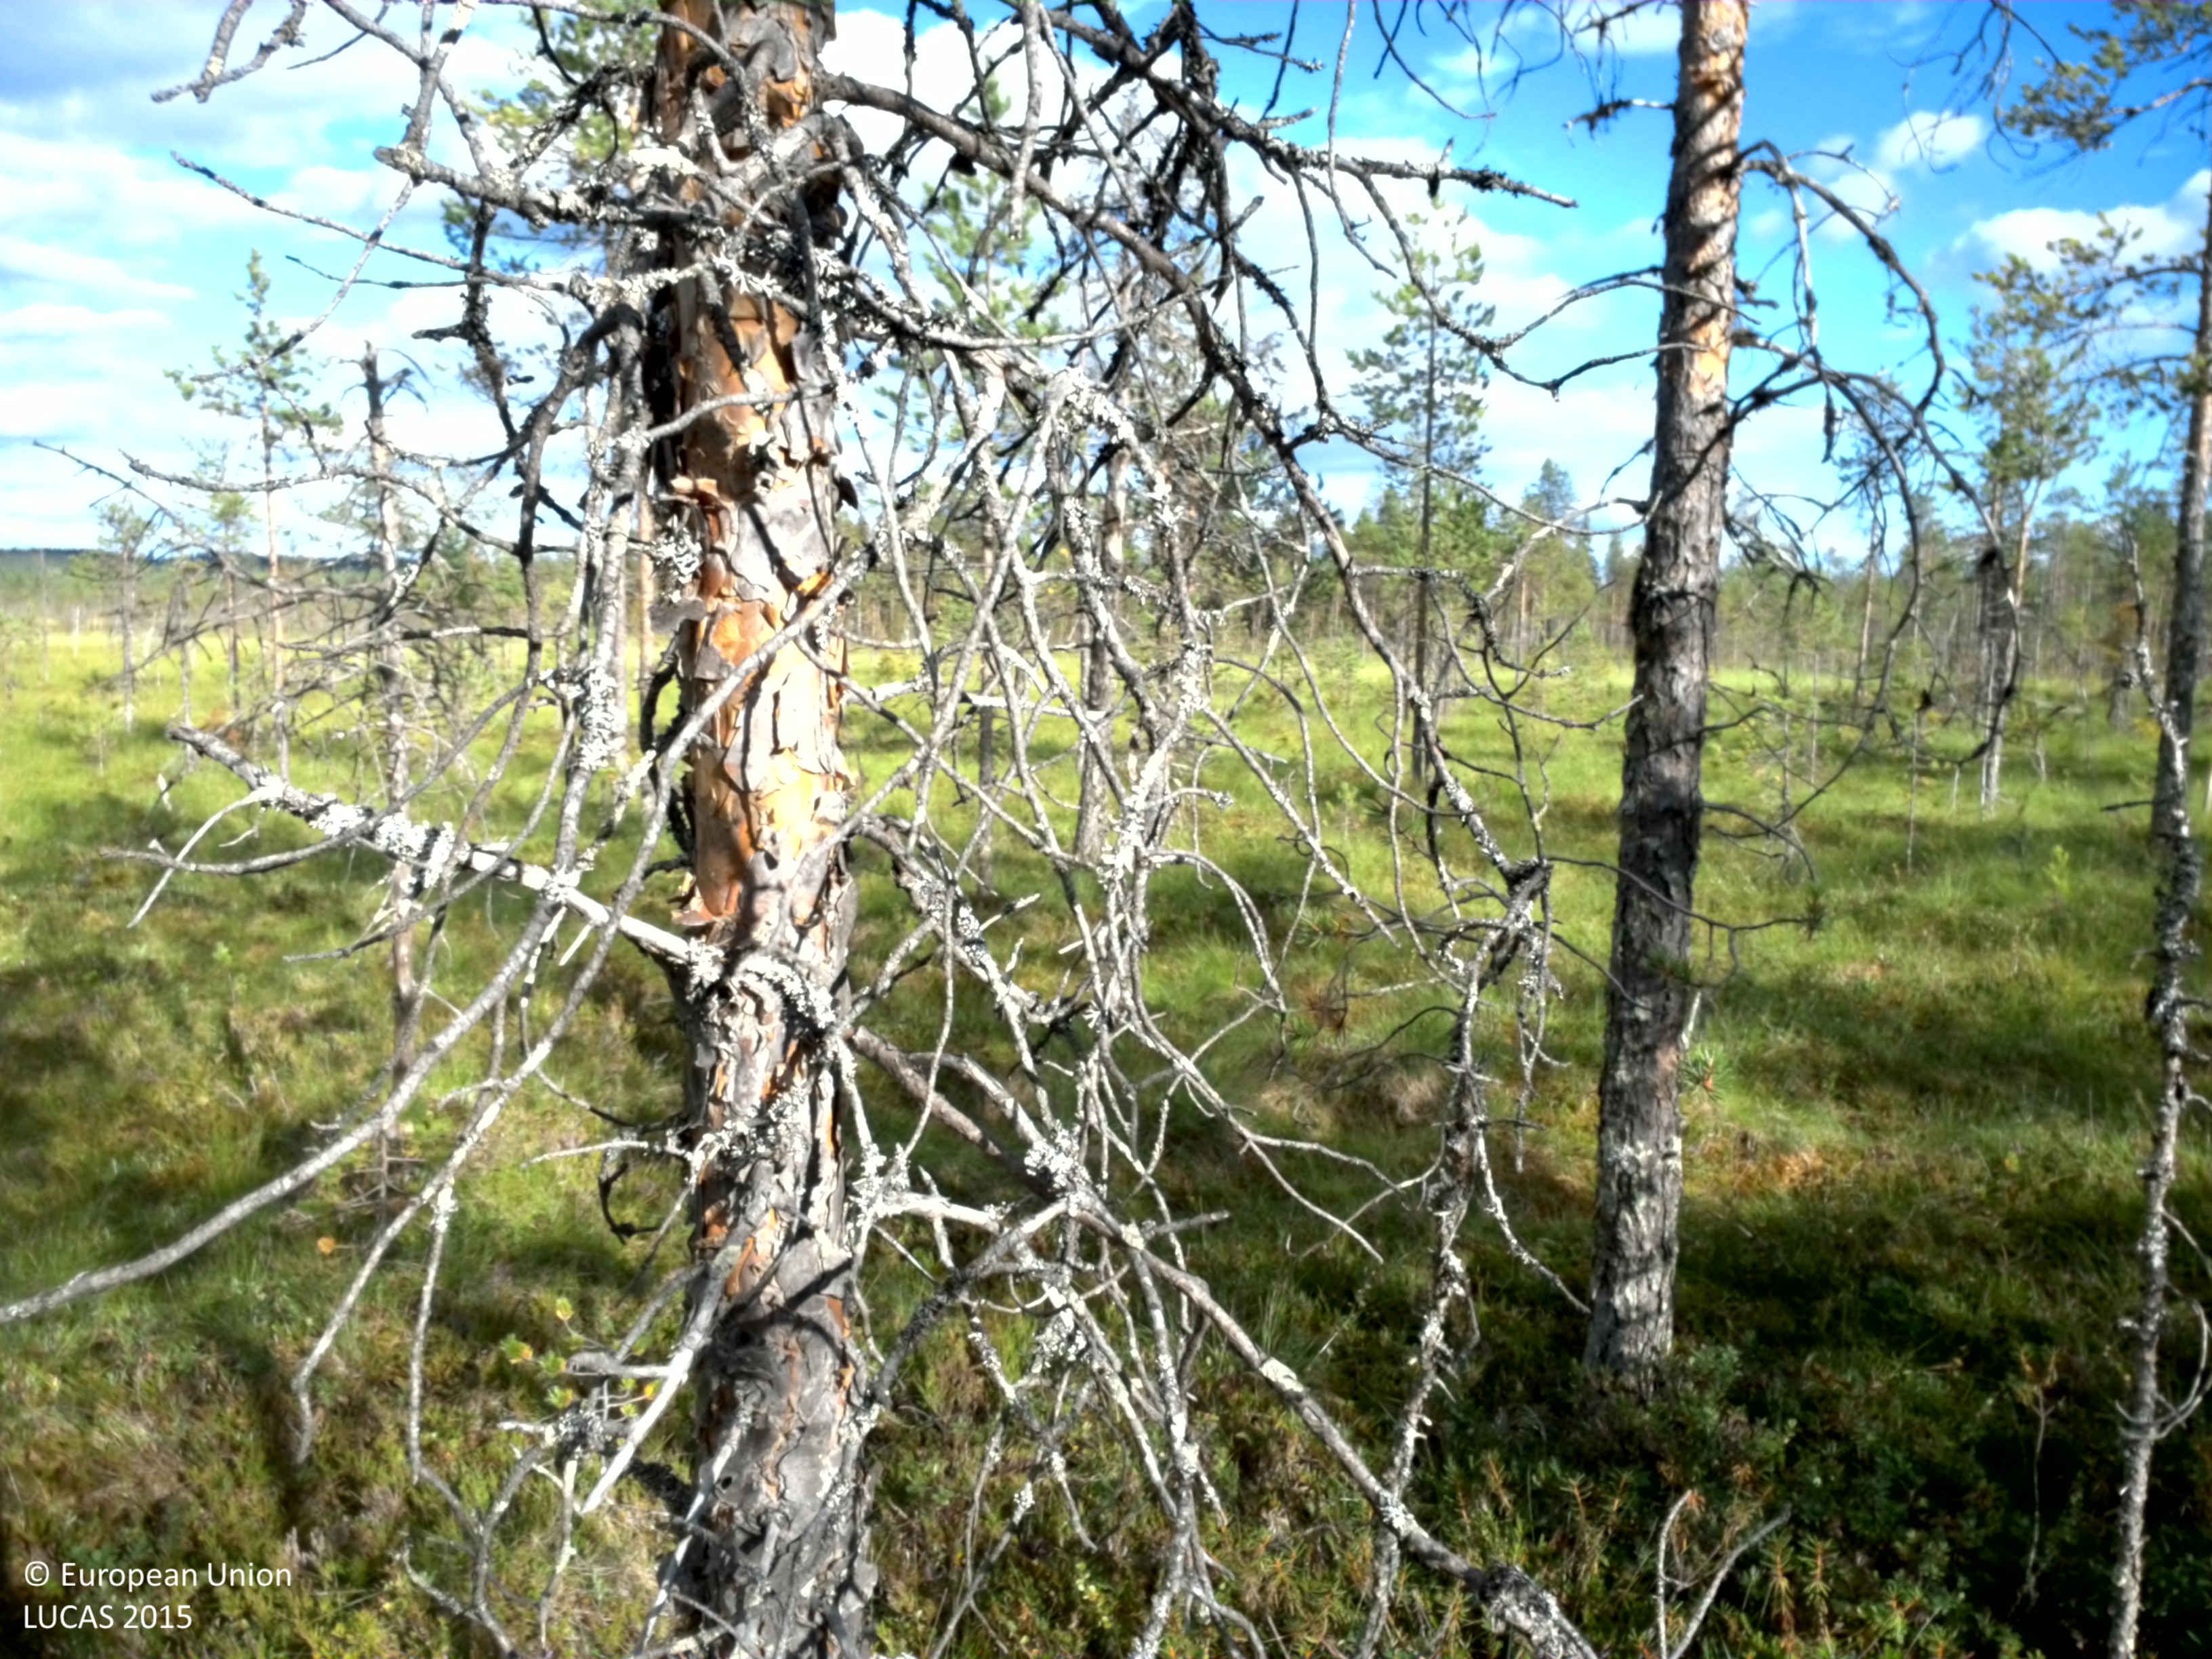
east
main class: Woodland
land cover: Pine dominated coniferous woodland
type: boreal forest
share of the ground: 10 - 25 %
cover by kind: shrubs 70 %, coniferous forest trees 15 %, herbaceous plants 10 %, lichens and mosses 5 %
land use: Semi-natural and natural areas not in use
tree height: > 5 m
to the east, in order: Pine dominated coniferous woodland; Shrubland with sparse tree cover; Peatbogs; Shrubland with sparse tree cover; Spruce dominated coniferous woodland; Shrubland with sparse tree cover; Peatbogs
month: August
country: SE
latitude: 66.1635
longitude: 22.6846
